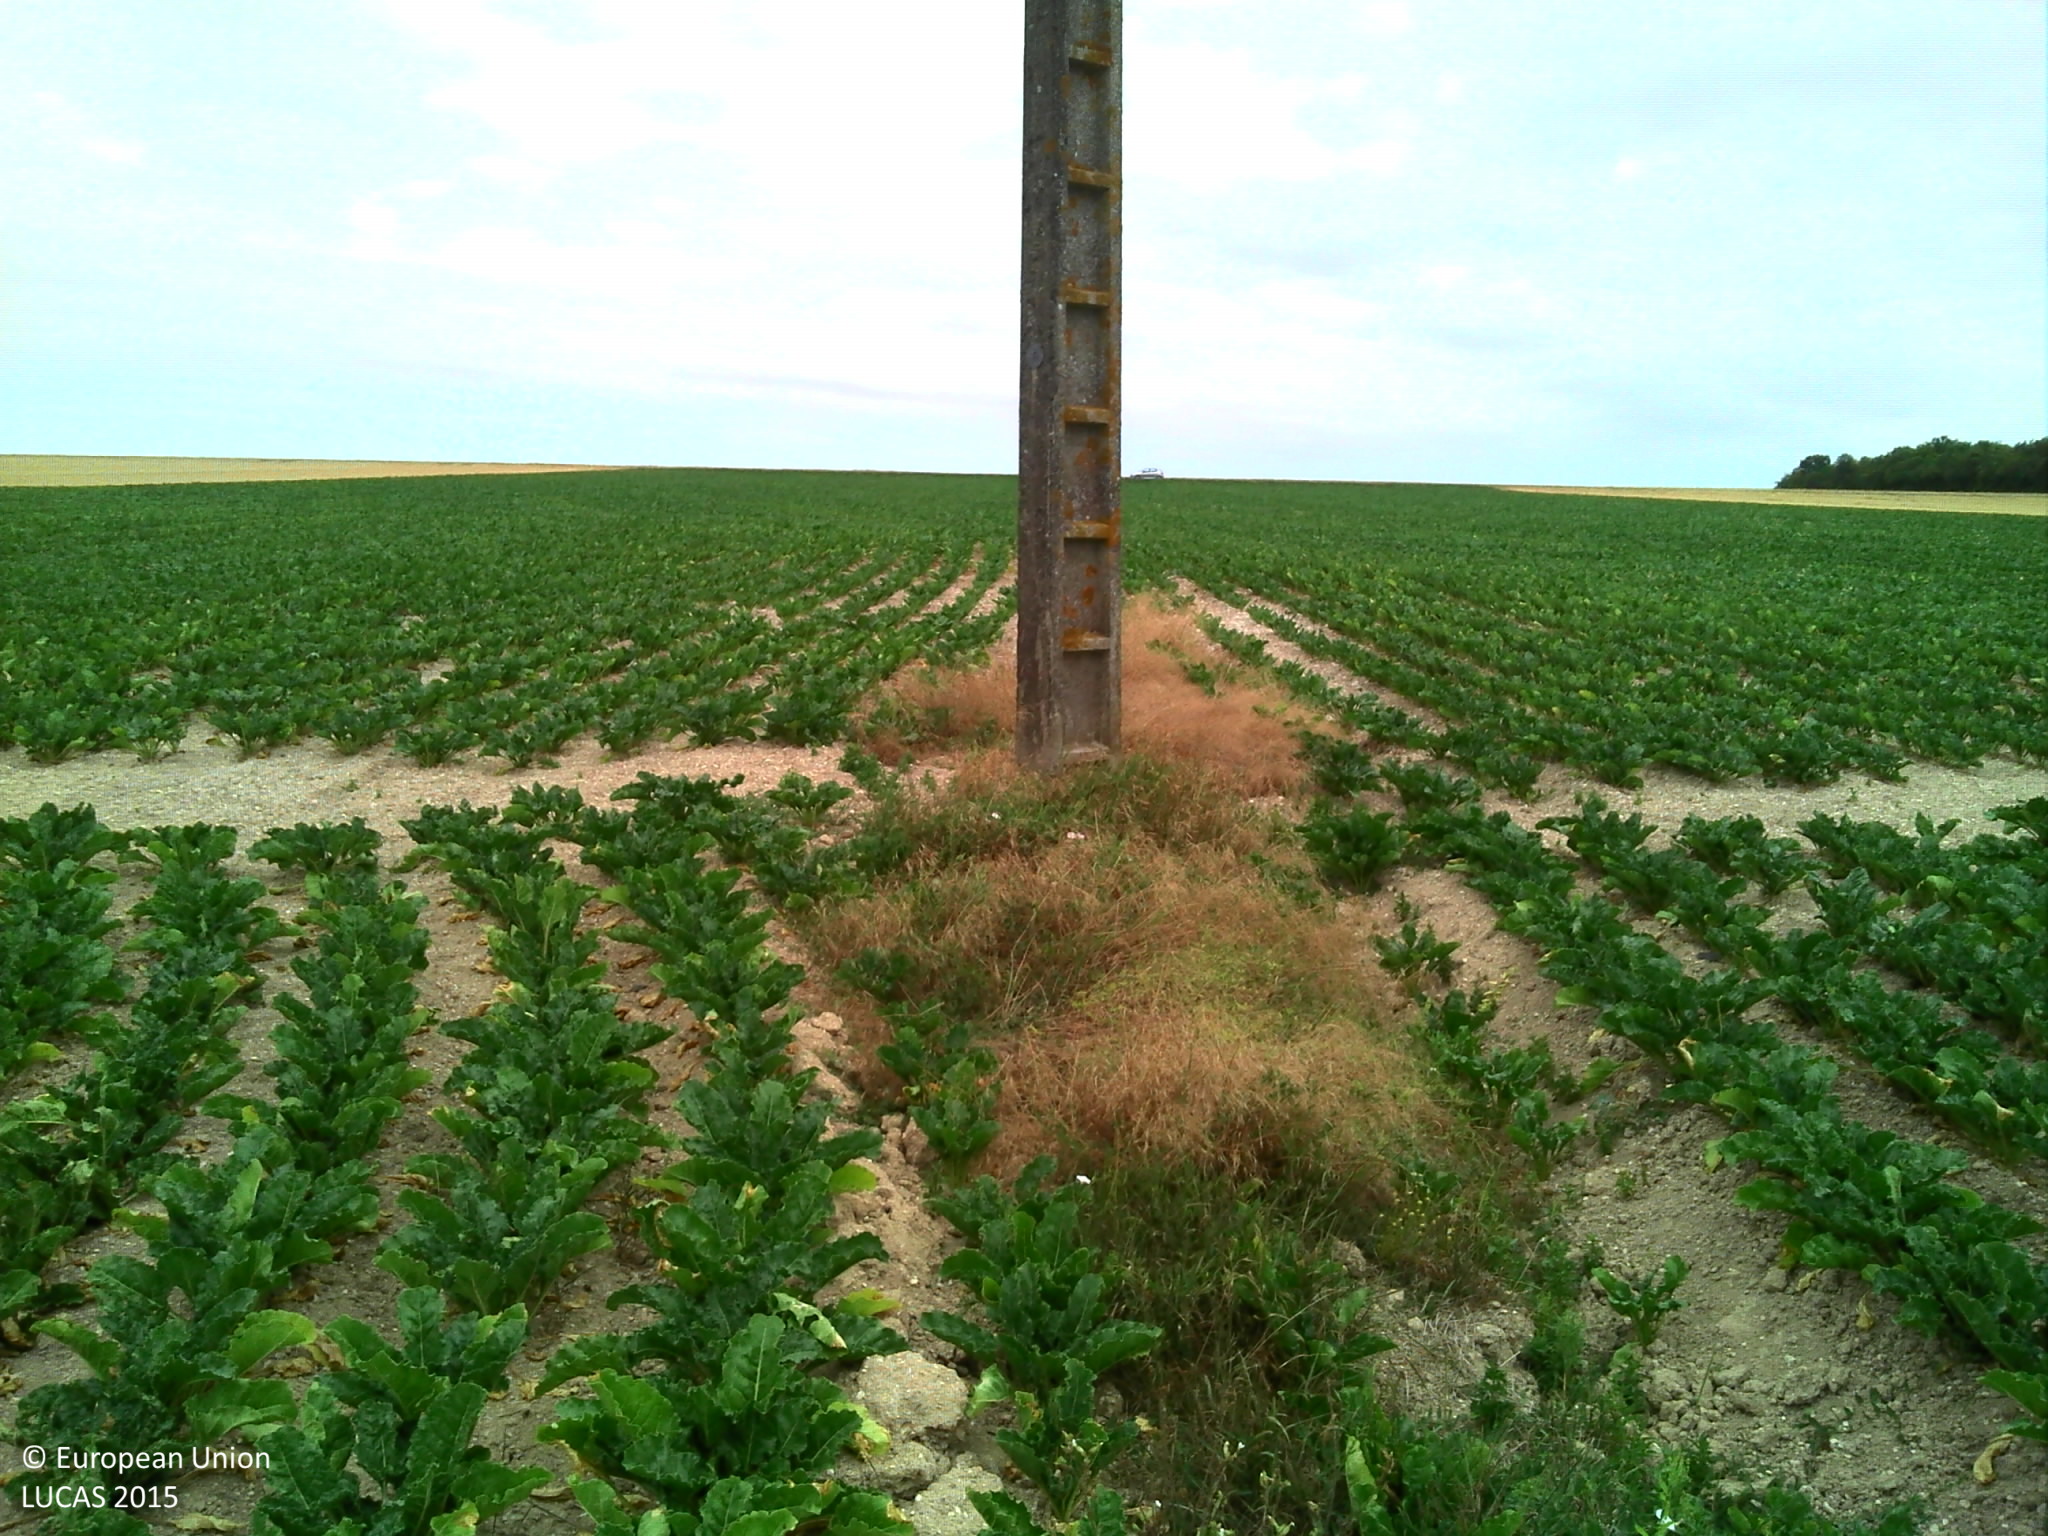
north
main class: Cropland
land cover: Sugar beet
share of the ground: > 75 %
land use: Agriculture (excluding fallow land and kitchen gardens)
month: July
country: FR
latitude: 49.3995
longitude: 4.0836
